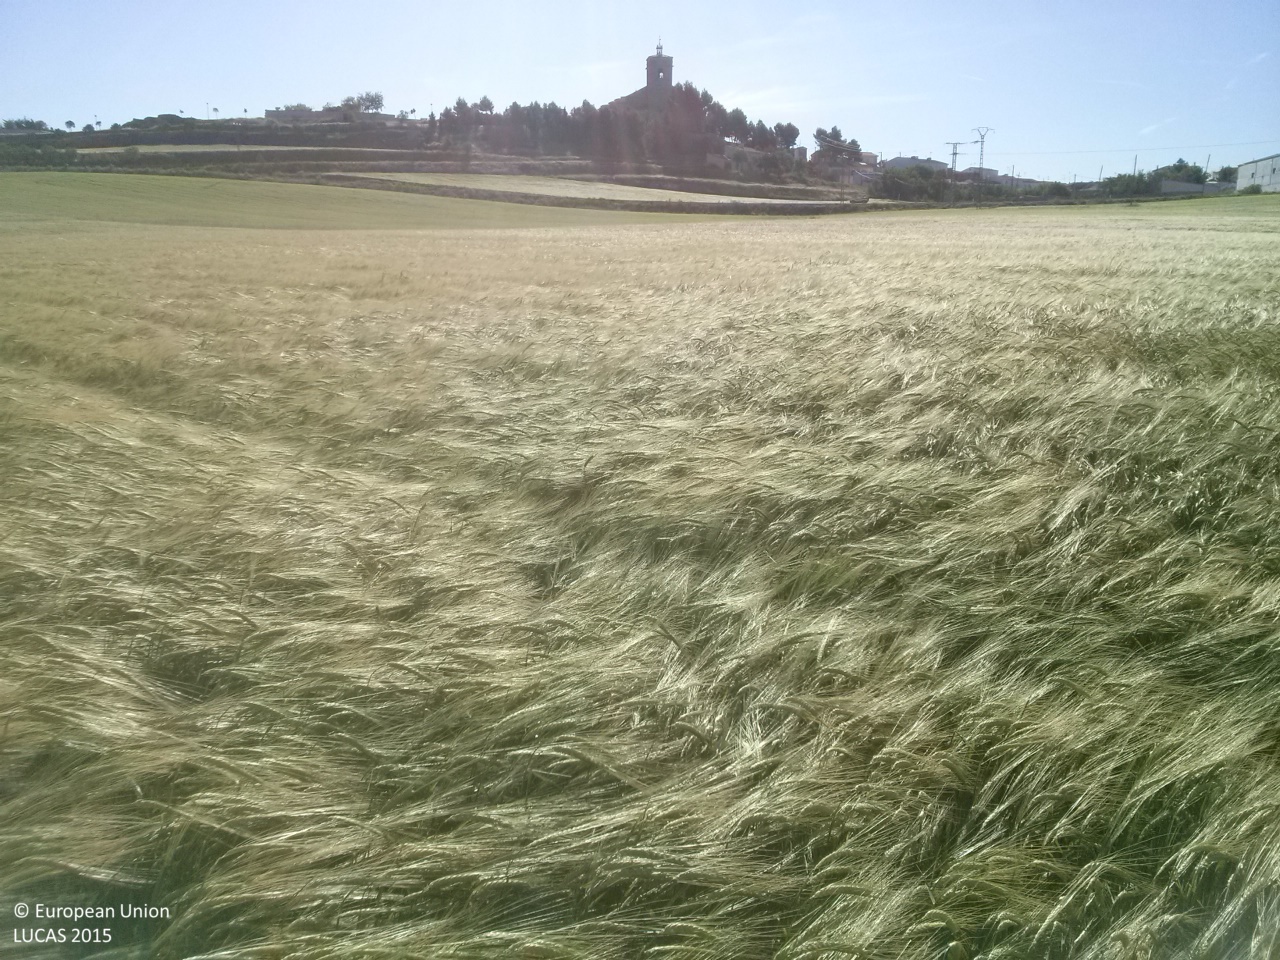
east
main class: Cropland
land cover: Barley
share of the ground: > 75 %
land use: Agriculture (excluding fallow land and kitchen gardens)
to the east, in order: Barley; Electric lines; Grass margins; Paved roads, cycling and walking lanes; Grass margins; Barley
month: May
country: ES
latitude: 40.0637
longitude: -2.8134
